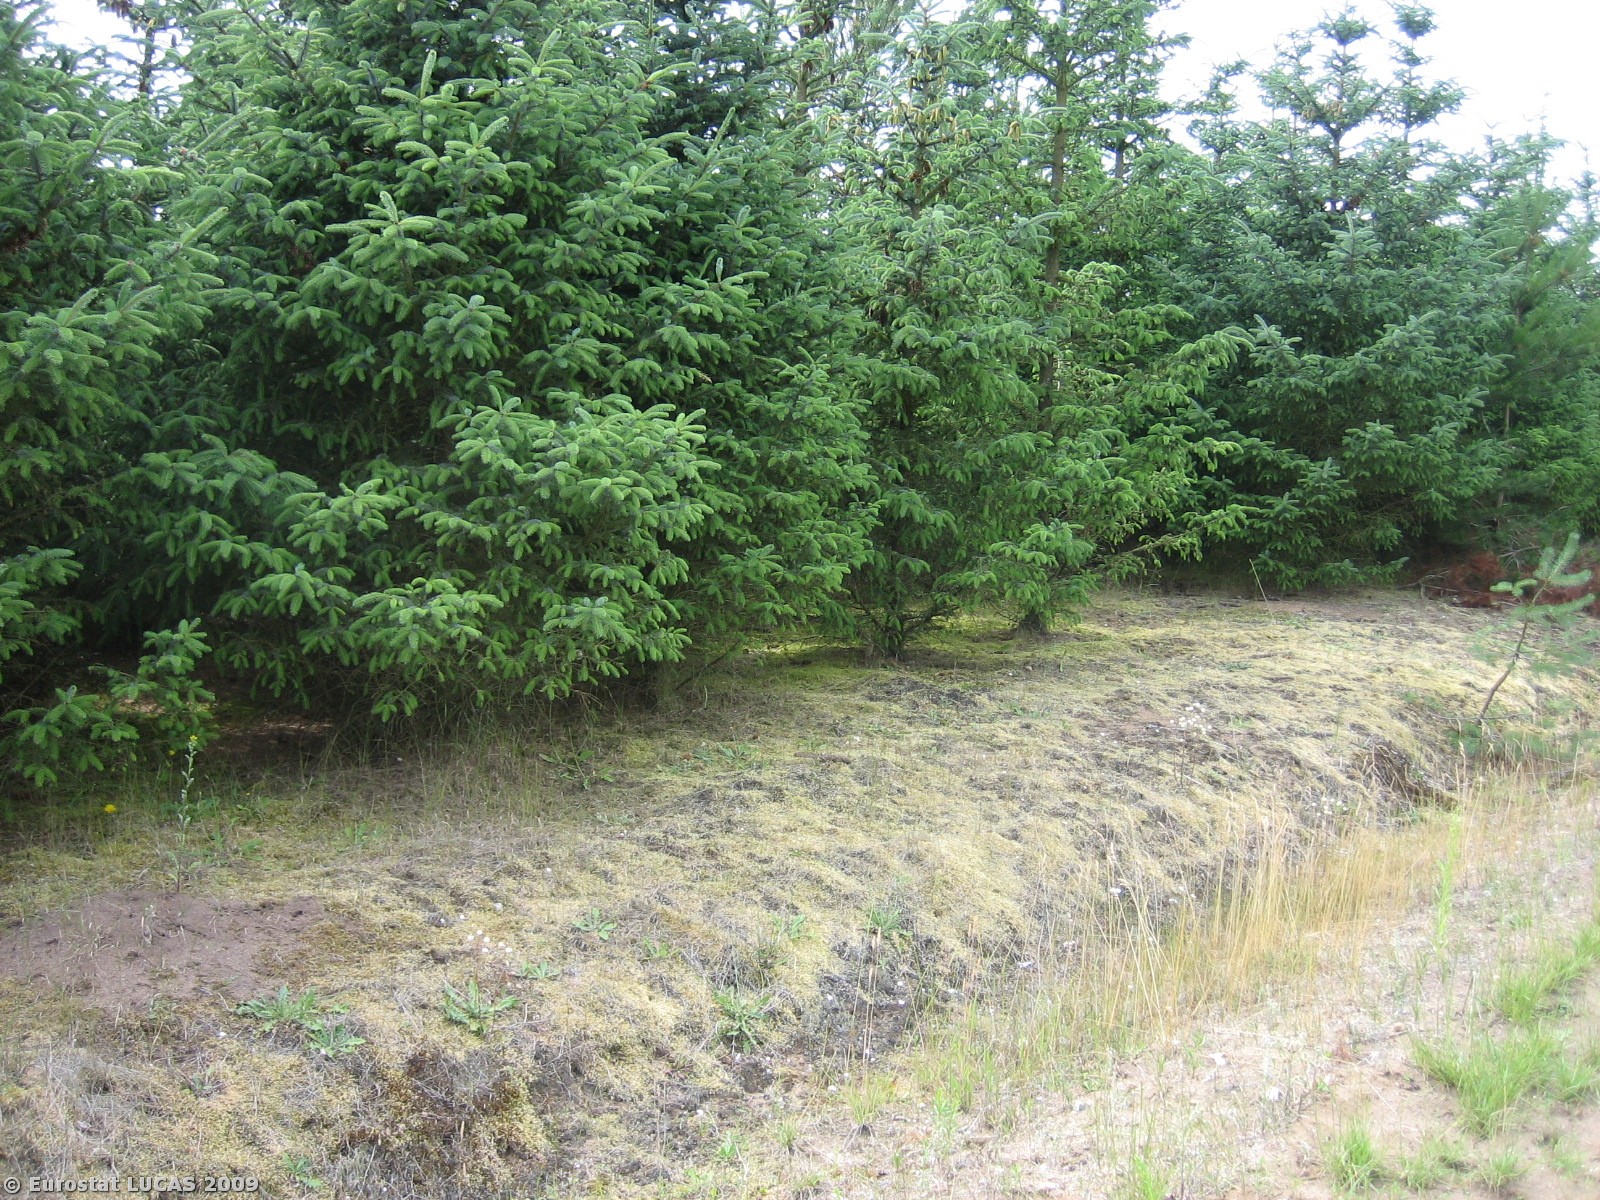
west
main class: Grassland
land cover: Grassland without tree/shrub cover
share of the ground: 50 - 75 %
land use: Forestry
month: July
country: DK
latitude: 55.8044
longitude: 8.7728
